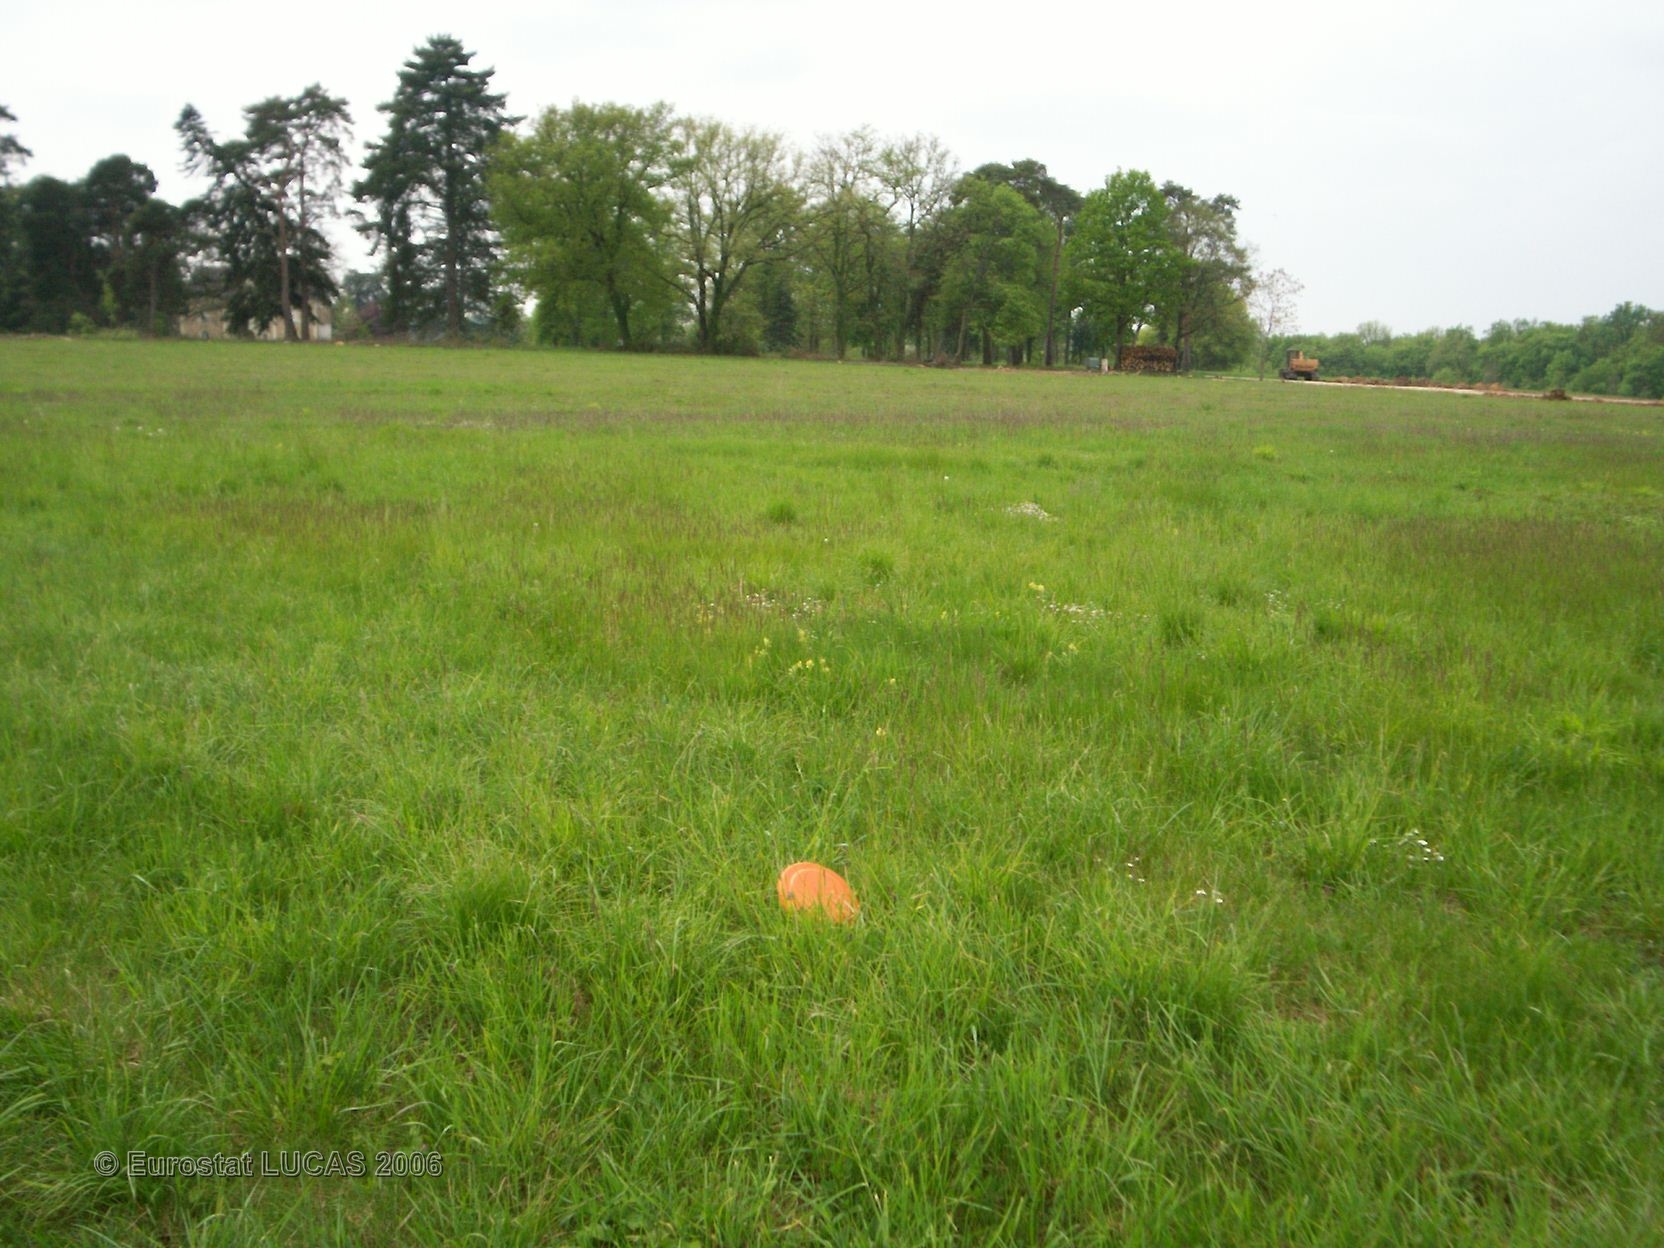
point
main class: Grassland
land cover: Grassland without tree/shrub cover
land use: Agriculture (excluding fallow land and kitchen gardens)
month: May
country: FR
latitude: 47.4164
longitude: 0.5288
